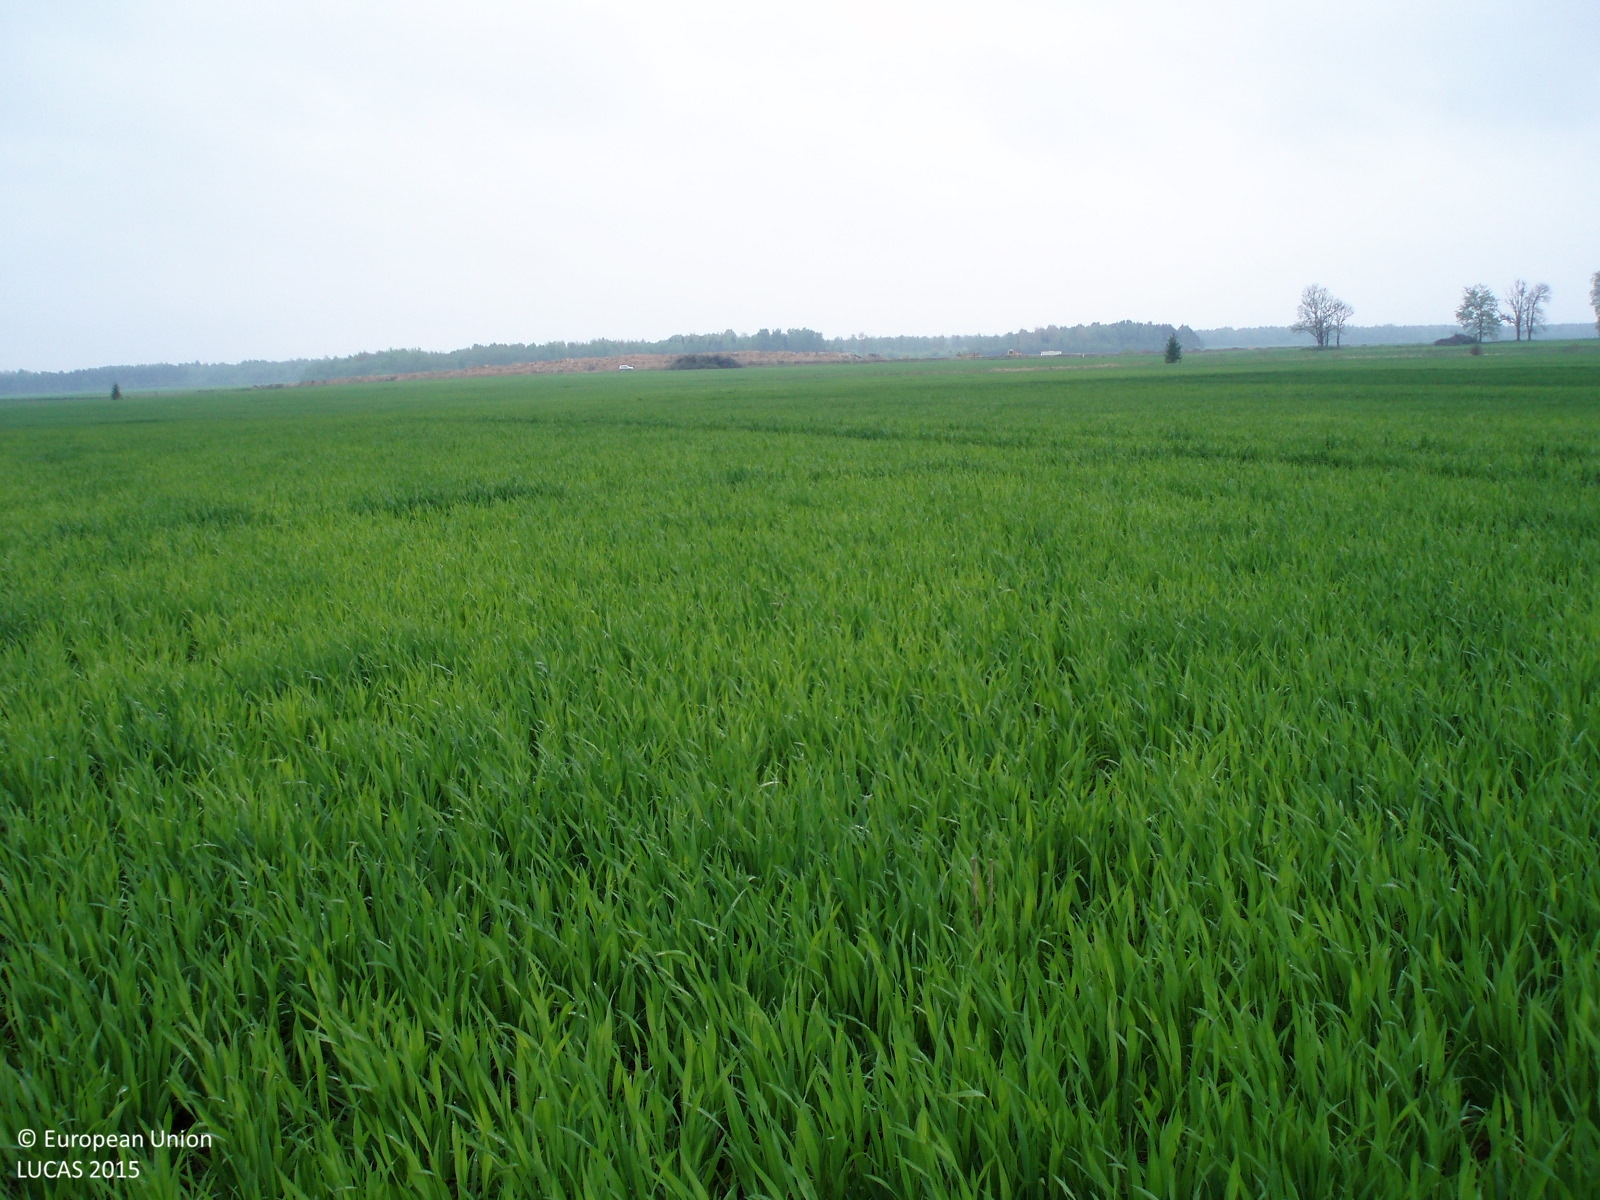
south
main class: Cropland
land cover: Common wheat
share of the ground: > 75 %
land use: Agriculture (excluding fallow land and kitchen gardens)
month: May
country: LT
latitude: 56.4004
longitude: 22.9795
